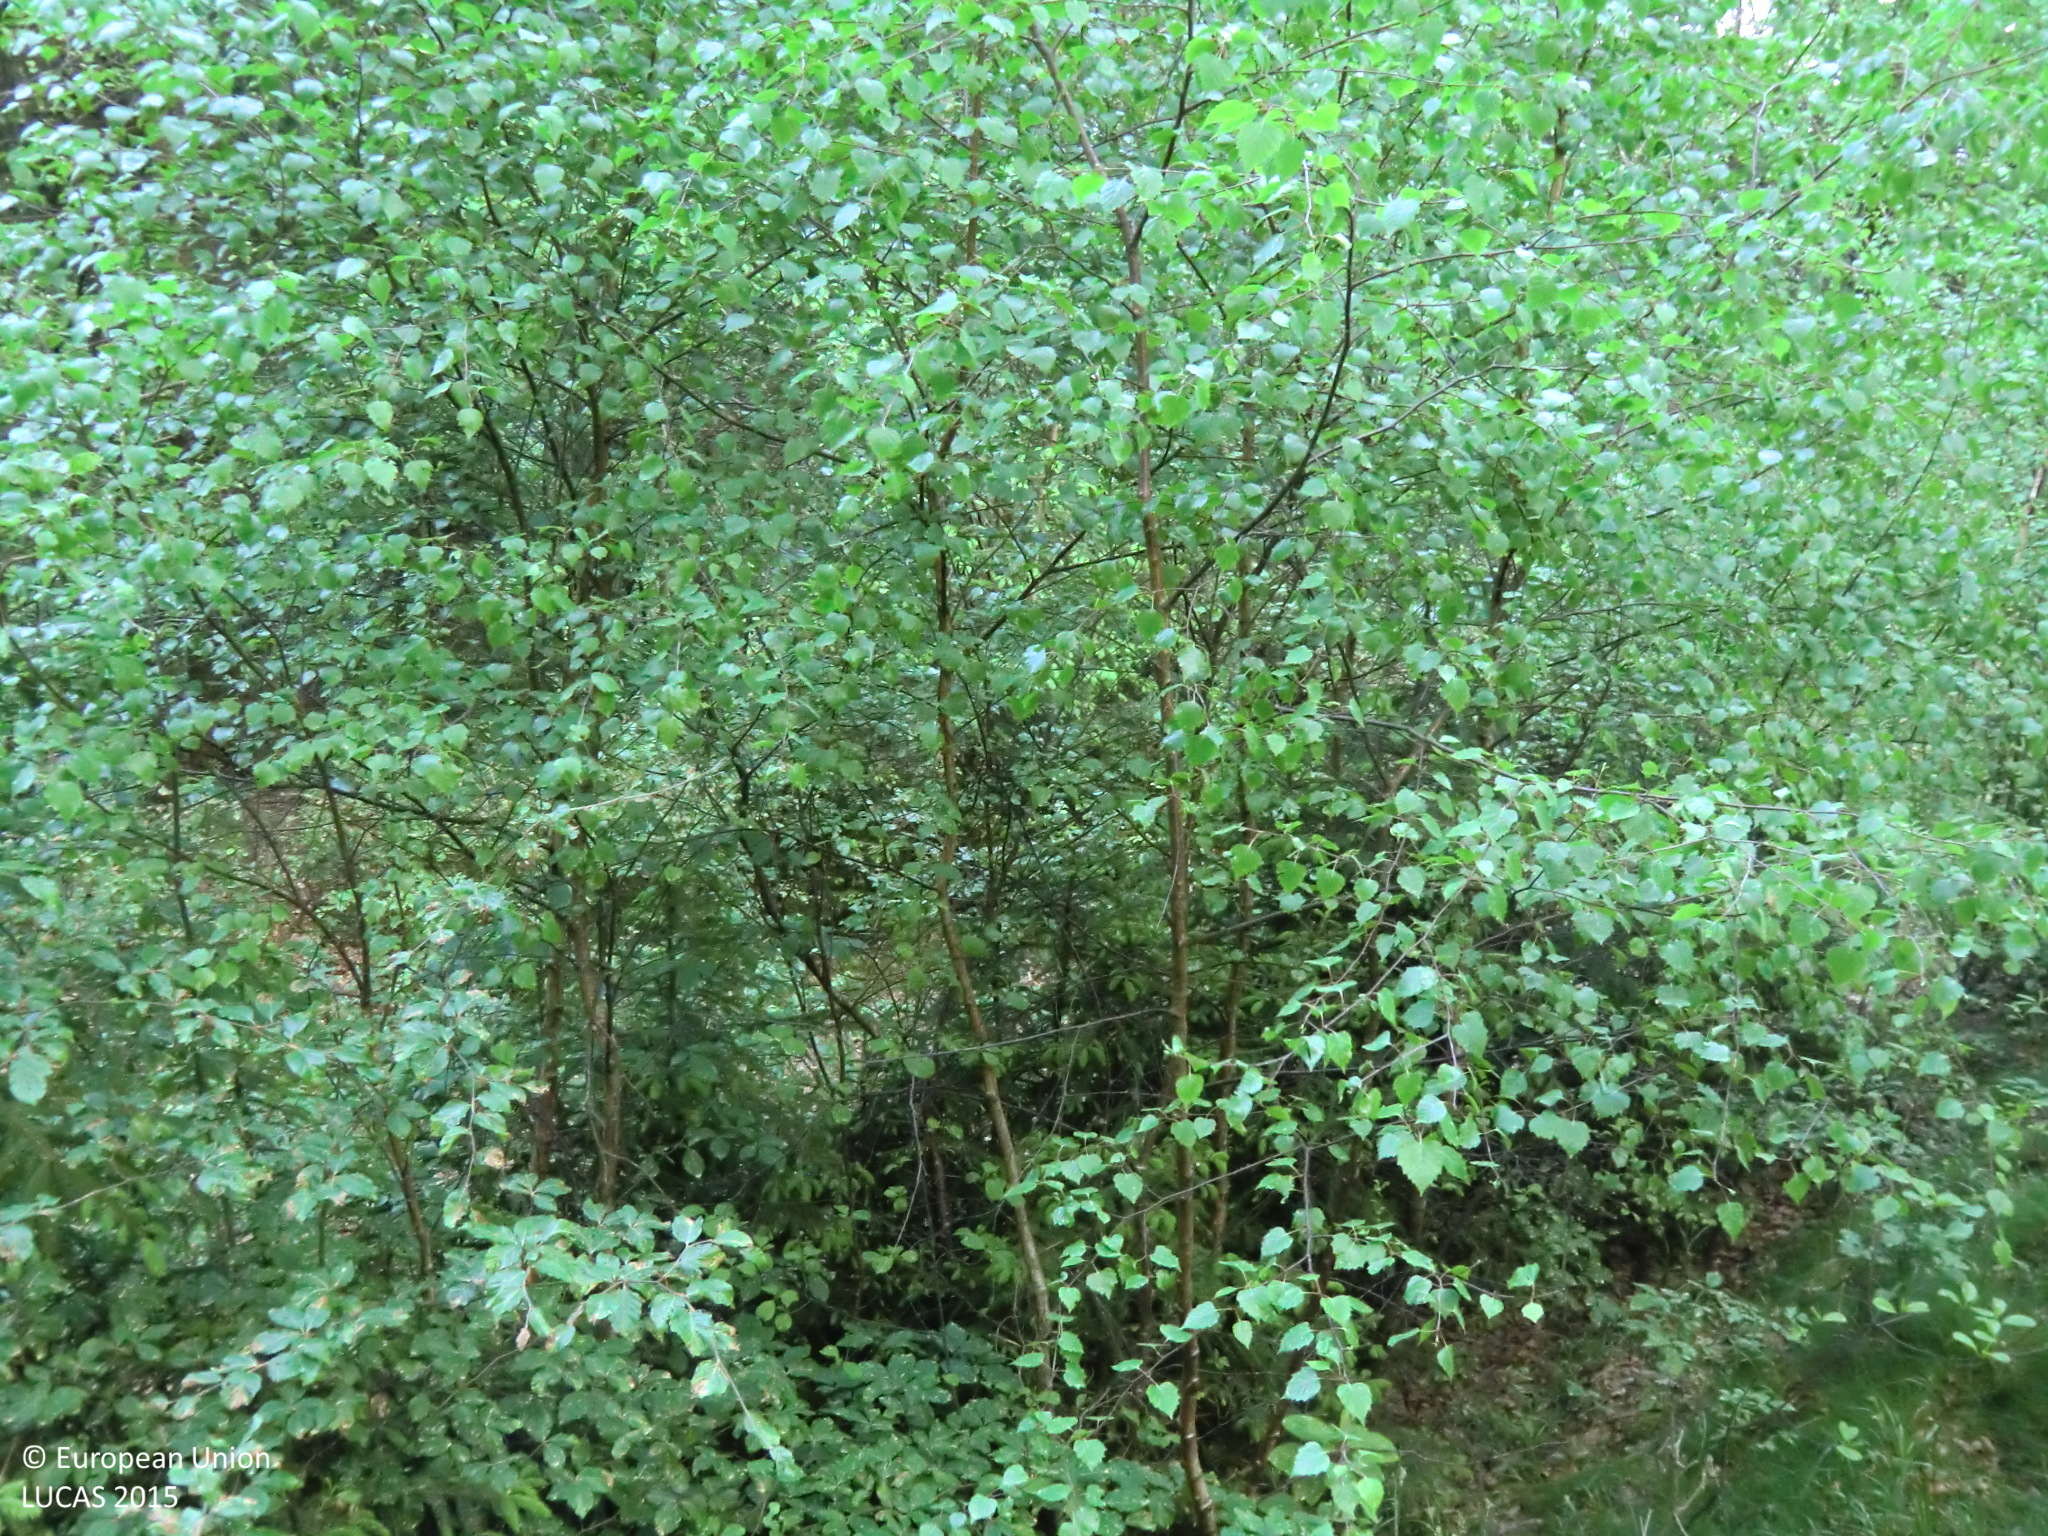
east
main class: Woodland
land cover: Other mixed woodland
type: hemiboreal forest and nemoral coniferous forest and mixed broadleaved-coniferous forest
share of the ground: 50 - 75 %
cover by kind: coniferous forest trees 30 %, broadleaved forest trees 30 %, shrubs 20 %, herbaceous plants 20 %
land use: Forestry
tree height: > 5 m
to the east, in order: Other mixed woodland; Tracks; Spruce dominated mixed woodland; Broadleaved woodland; Grassland without tree/shrub cover; Broadleaved woodland; Cherry fruit; Tracks; Grassland without tree/shrub cover; Other bare soil; Tracks; Pear fruit
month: May
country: AT
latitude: 48.3927
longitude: 14.2814
